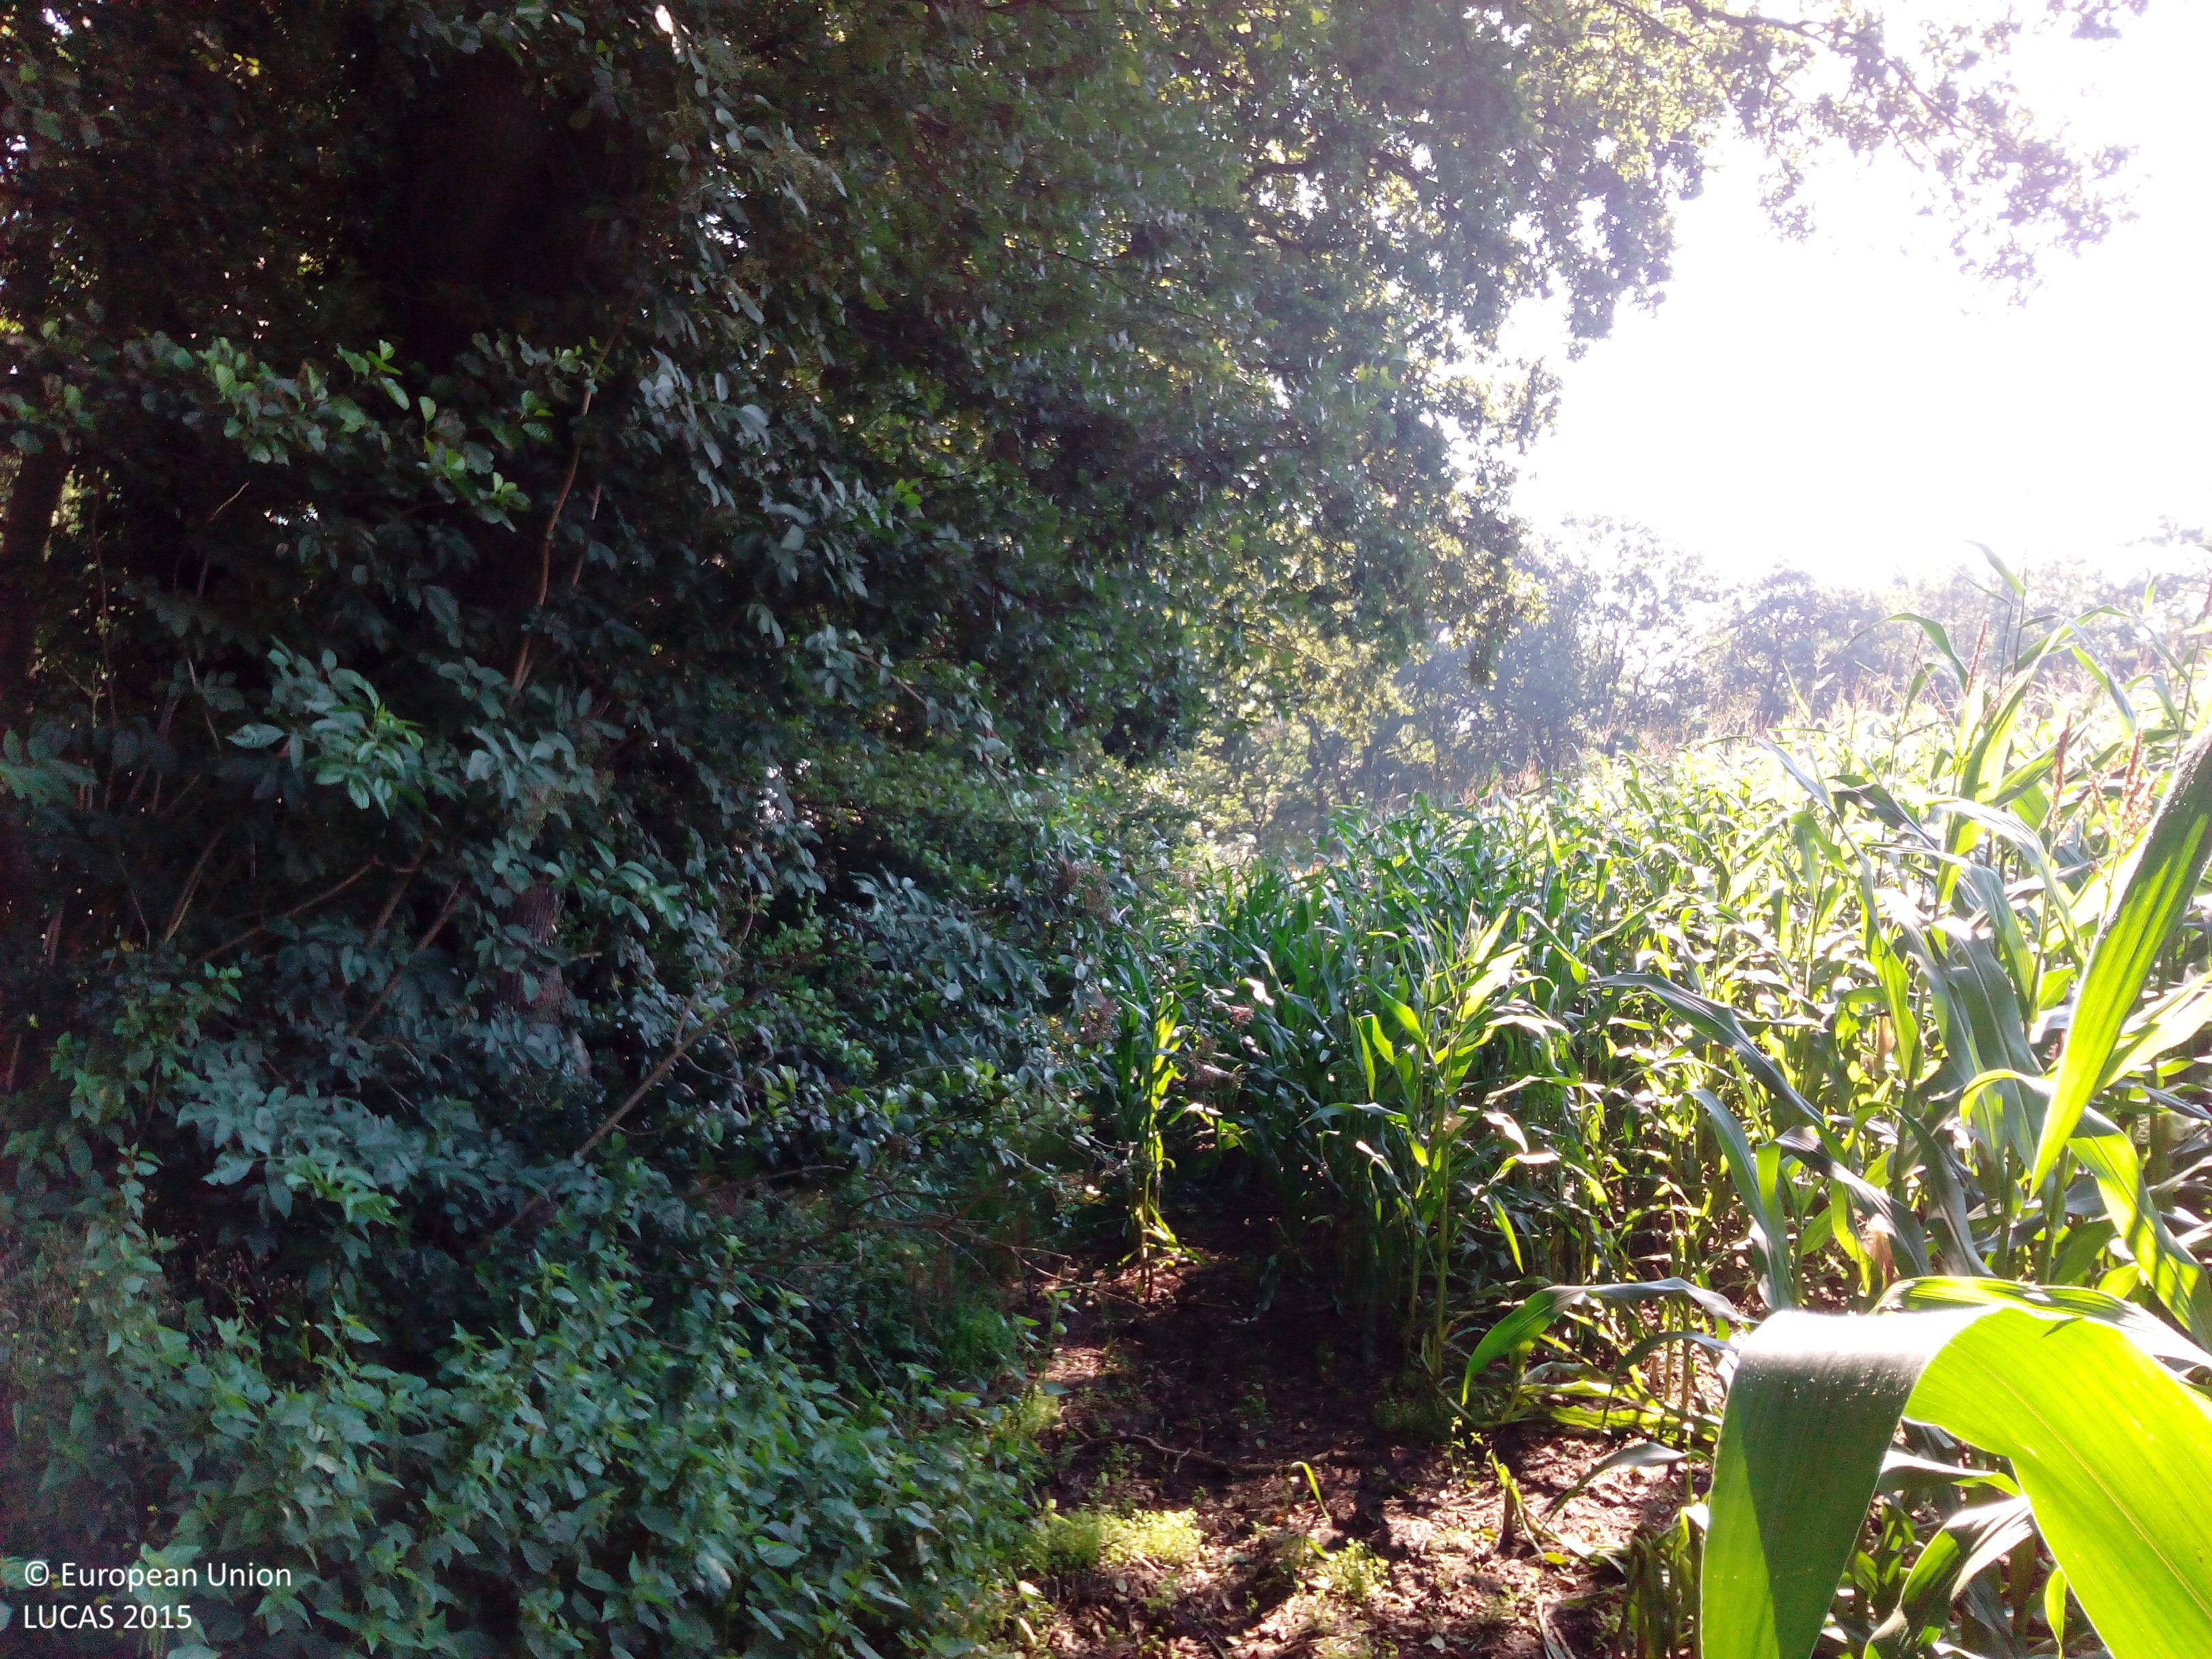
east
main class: Cropland
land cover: Maize
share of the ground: > 75 %
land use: Agriculture (excluding fallow land and kitchen gardens)
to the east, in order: Maize; Lines of trees; Ditches and canals; Paved roads, cycling and walking lanes; Grass margins; Paved roads, cycling and walking lanes; Lines of trees; Ditches and canals; Triticale; Lines of trees; Electric lines; Ditches and canals; Paved roads, cycling and walking lanes; Lines of trees; Ditches and canals; Grassland without tree/shrub cover; Ditches and canals; Grassland without tree/shrub cover
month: August
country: DE
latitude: 52.7023
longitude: 8.0027
